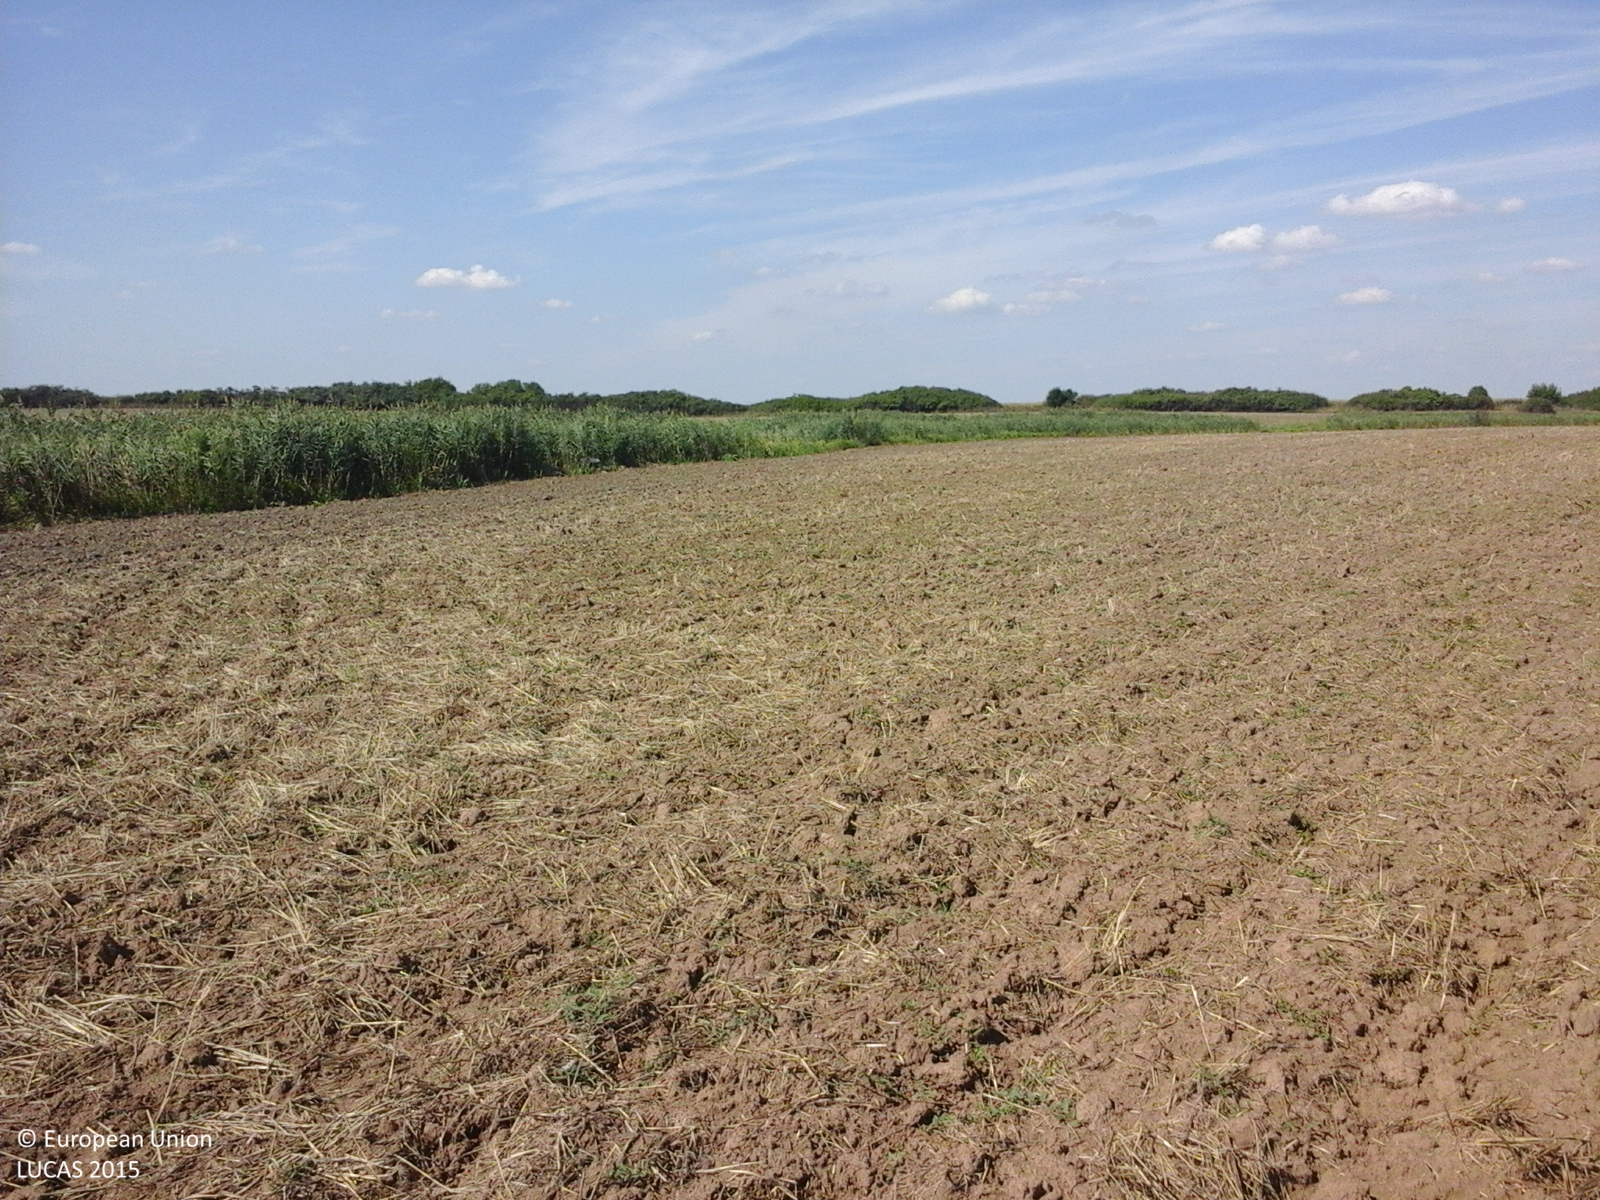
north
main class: Cropland
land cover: Common wheat
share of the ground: 25 - 50 %
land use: Agriculture (excluding fallow land and kitchen gardens)
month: August
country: RO
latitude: 45.7332
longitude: 21.1195
